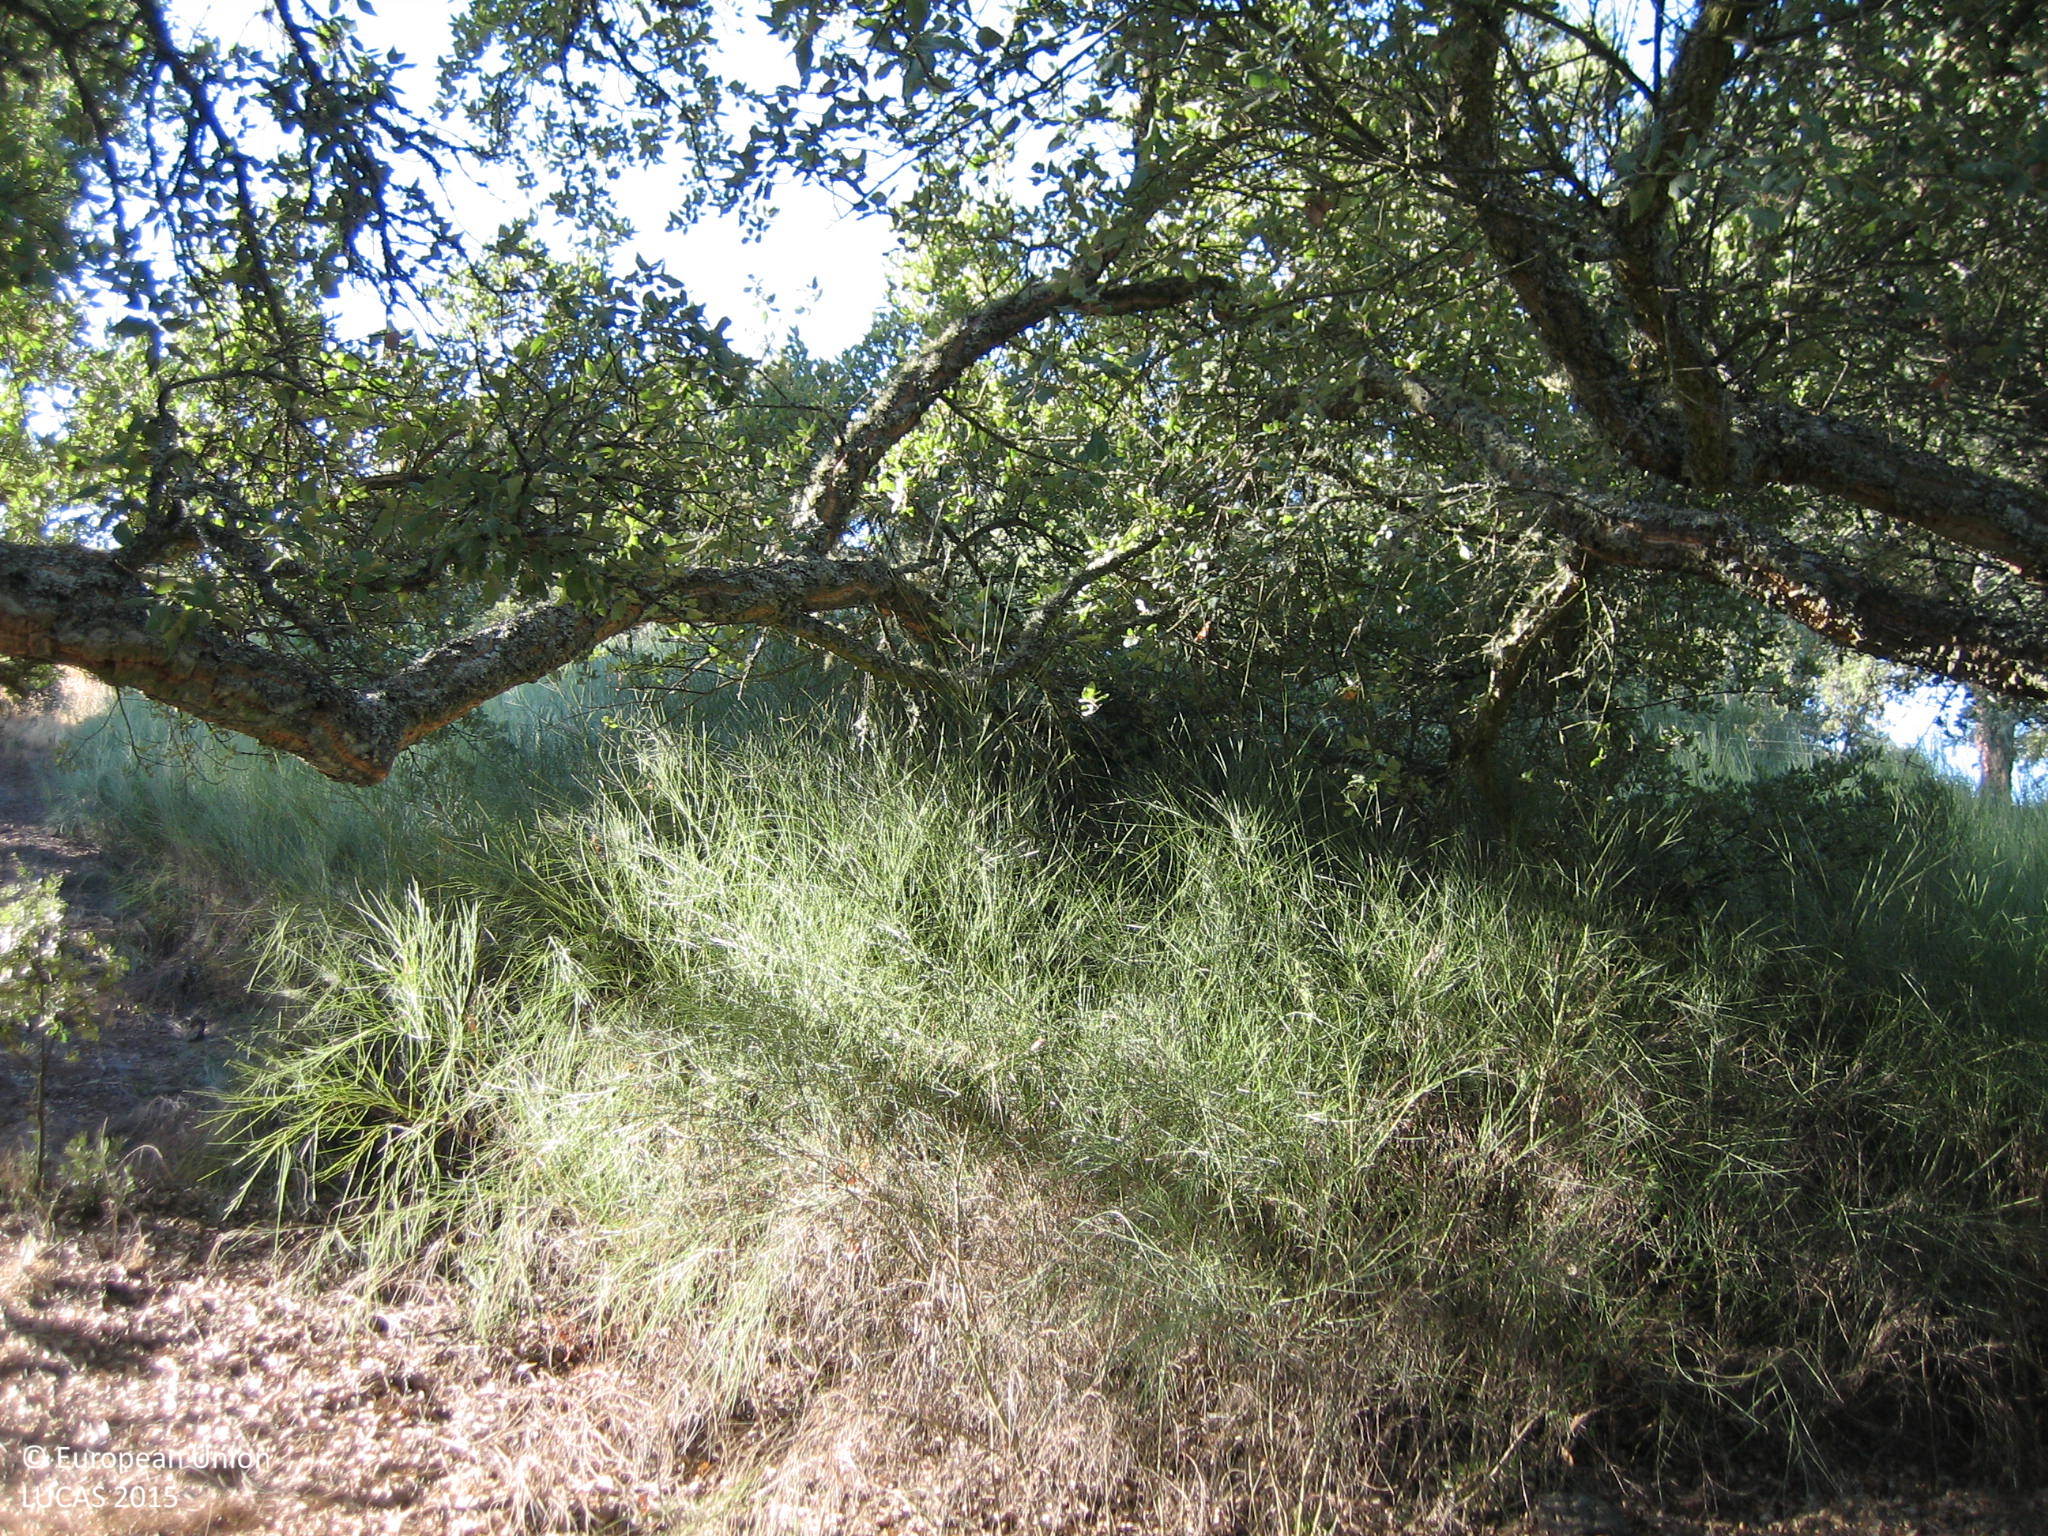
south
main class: Woodland
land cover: Broadleaved woodland
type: broadleaved evergreen forest
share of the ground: 50 - 75 %
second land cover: Shrubland without tree cover
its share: 25 - 50 %
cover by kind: broadleaved forest trees 60 %, shrubs 30 %, herbaceous plants 10 %
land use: Forestry
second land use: Agriculture (excluding fallow land and kitchen gardens)
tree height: > 5 m
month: August
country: ES
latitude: 38.0851
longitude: -6.2885
